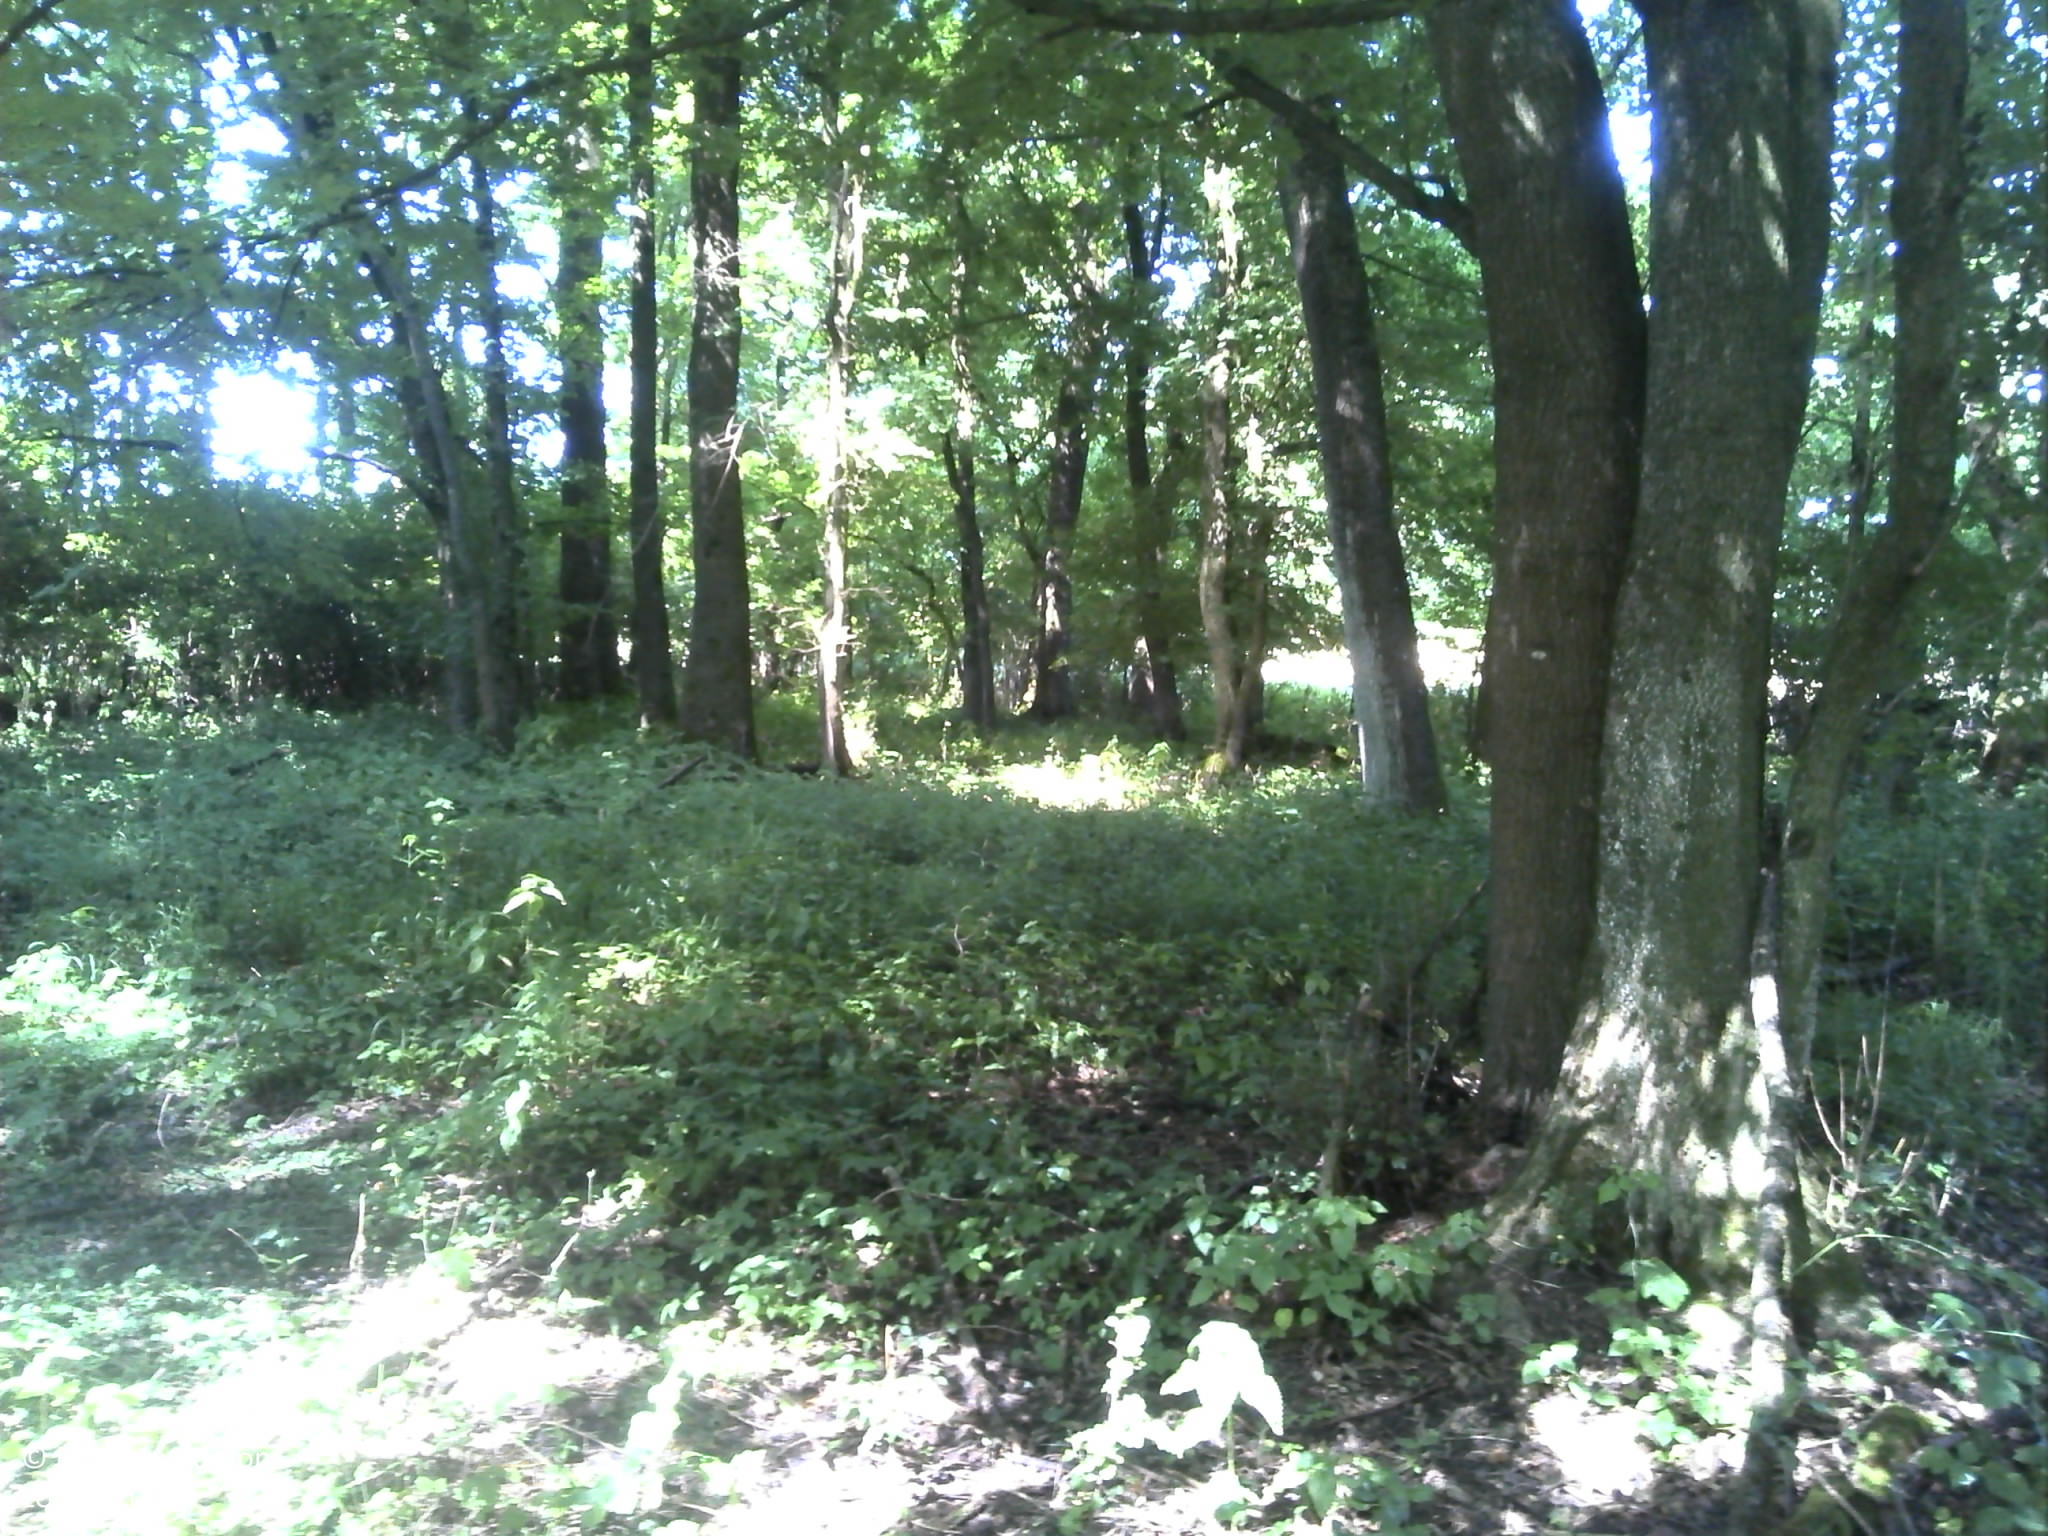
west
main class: Woodland
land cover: Broadleaved woodland
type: mesophytic deciduous forest
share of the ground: > 75 %
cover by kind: broadleaved forest trees 90 %, shrubs 5 %, herbaceous plants 5 %
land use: Forestry
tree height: > 5 m
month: July
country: HR
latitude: 45.8219
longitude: 16.8864
